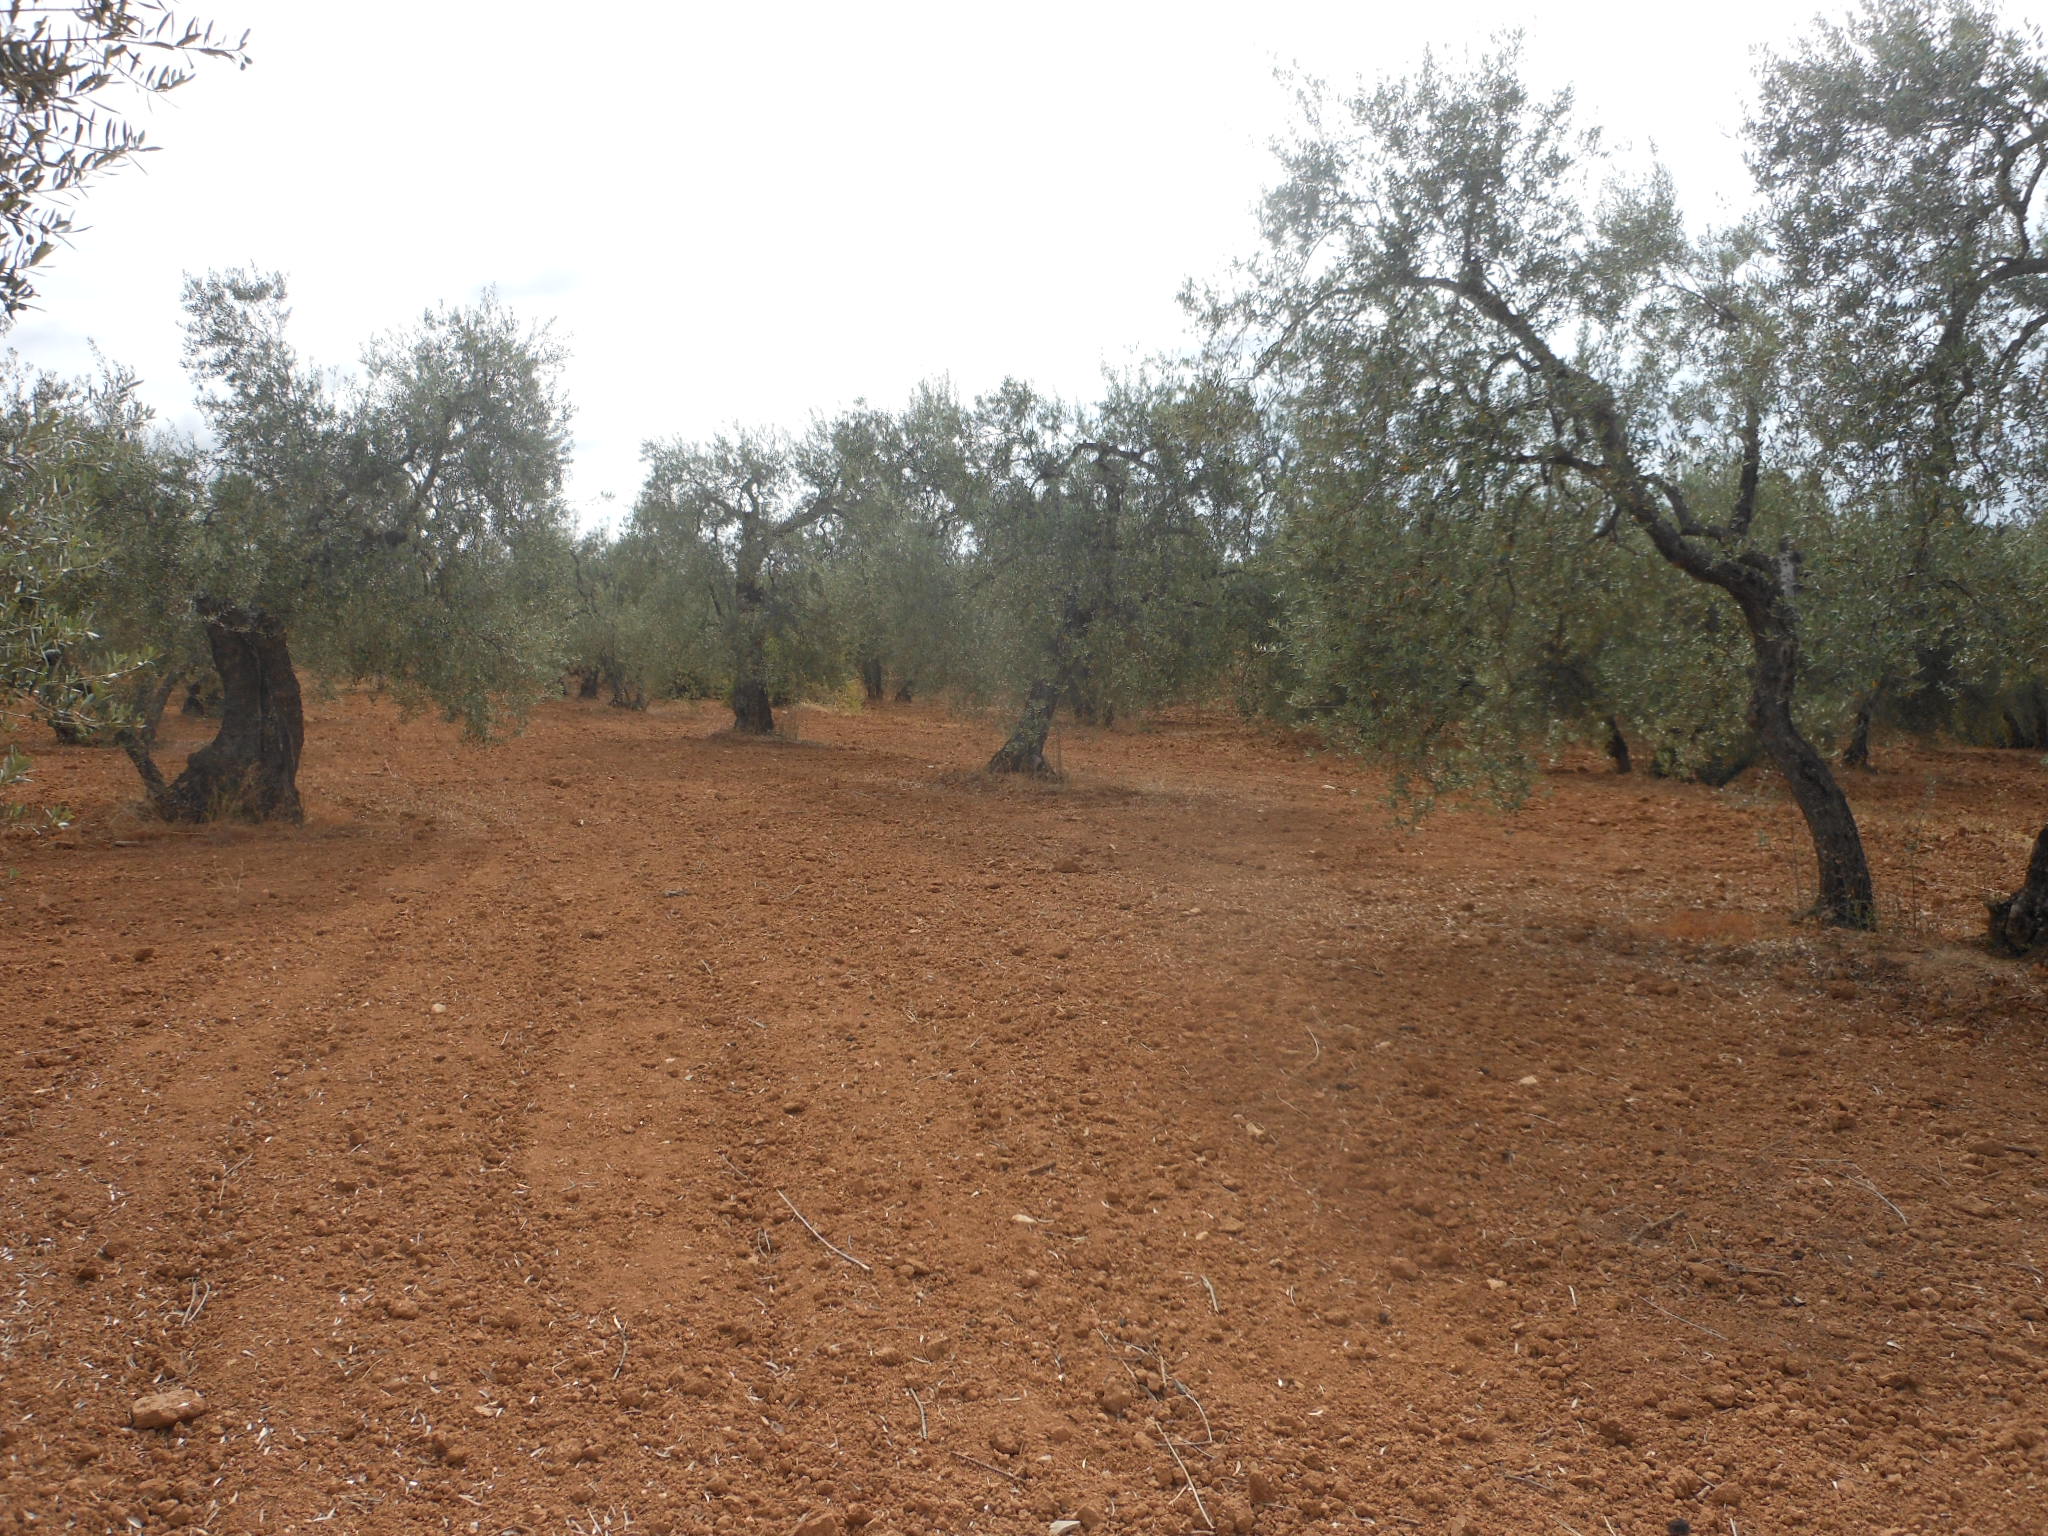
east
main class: Cropland
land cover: Olive groves
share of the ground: 50 - 75 %
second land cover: Other bare soil
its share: > 75 %
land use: Agriculture (excluding fallow land and kitchen gardens)
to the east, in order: Olive groves; Other bare soil; Tracks; Olive groves
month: June
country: ES
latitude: 37.2294
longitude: -5.4650
